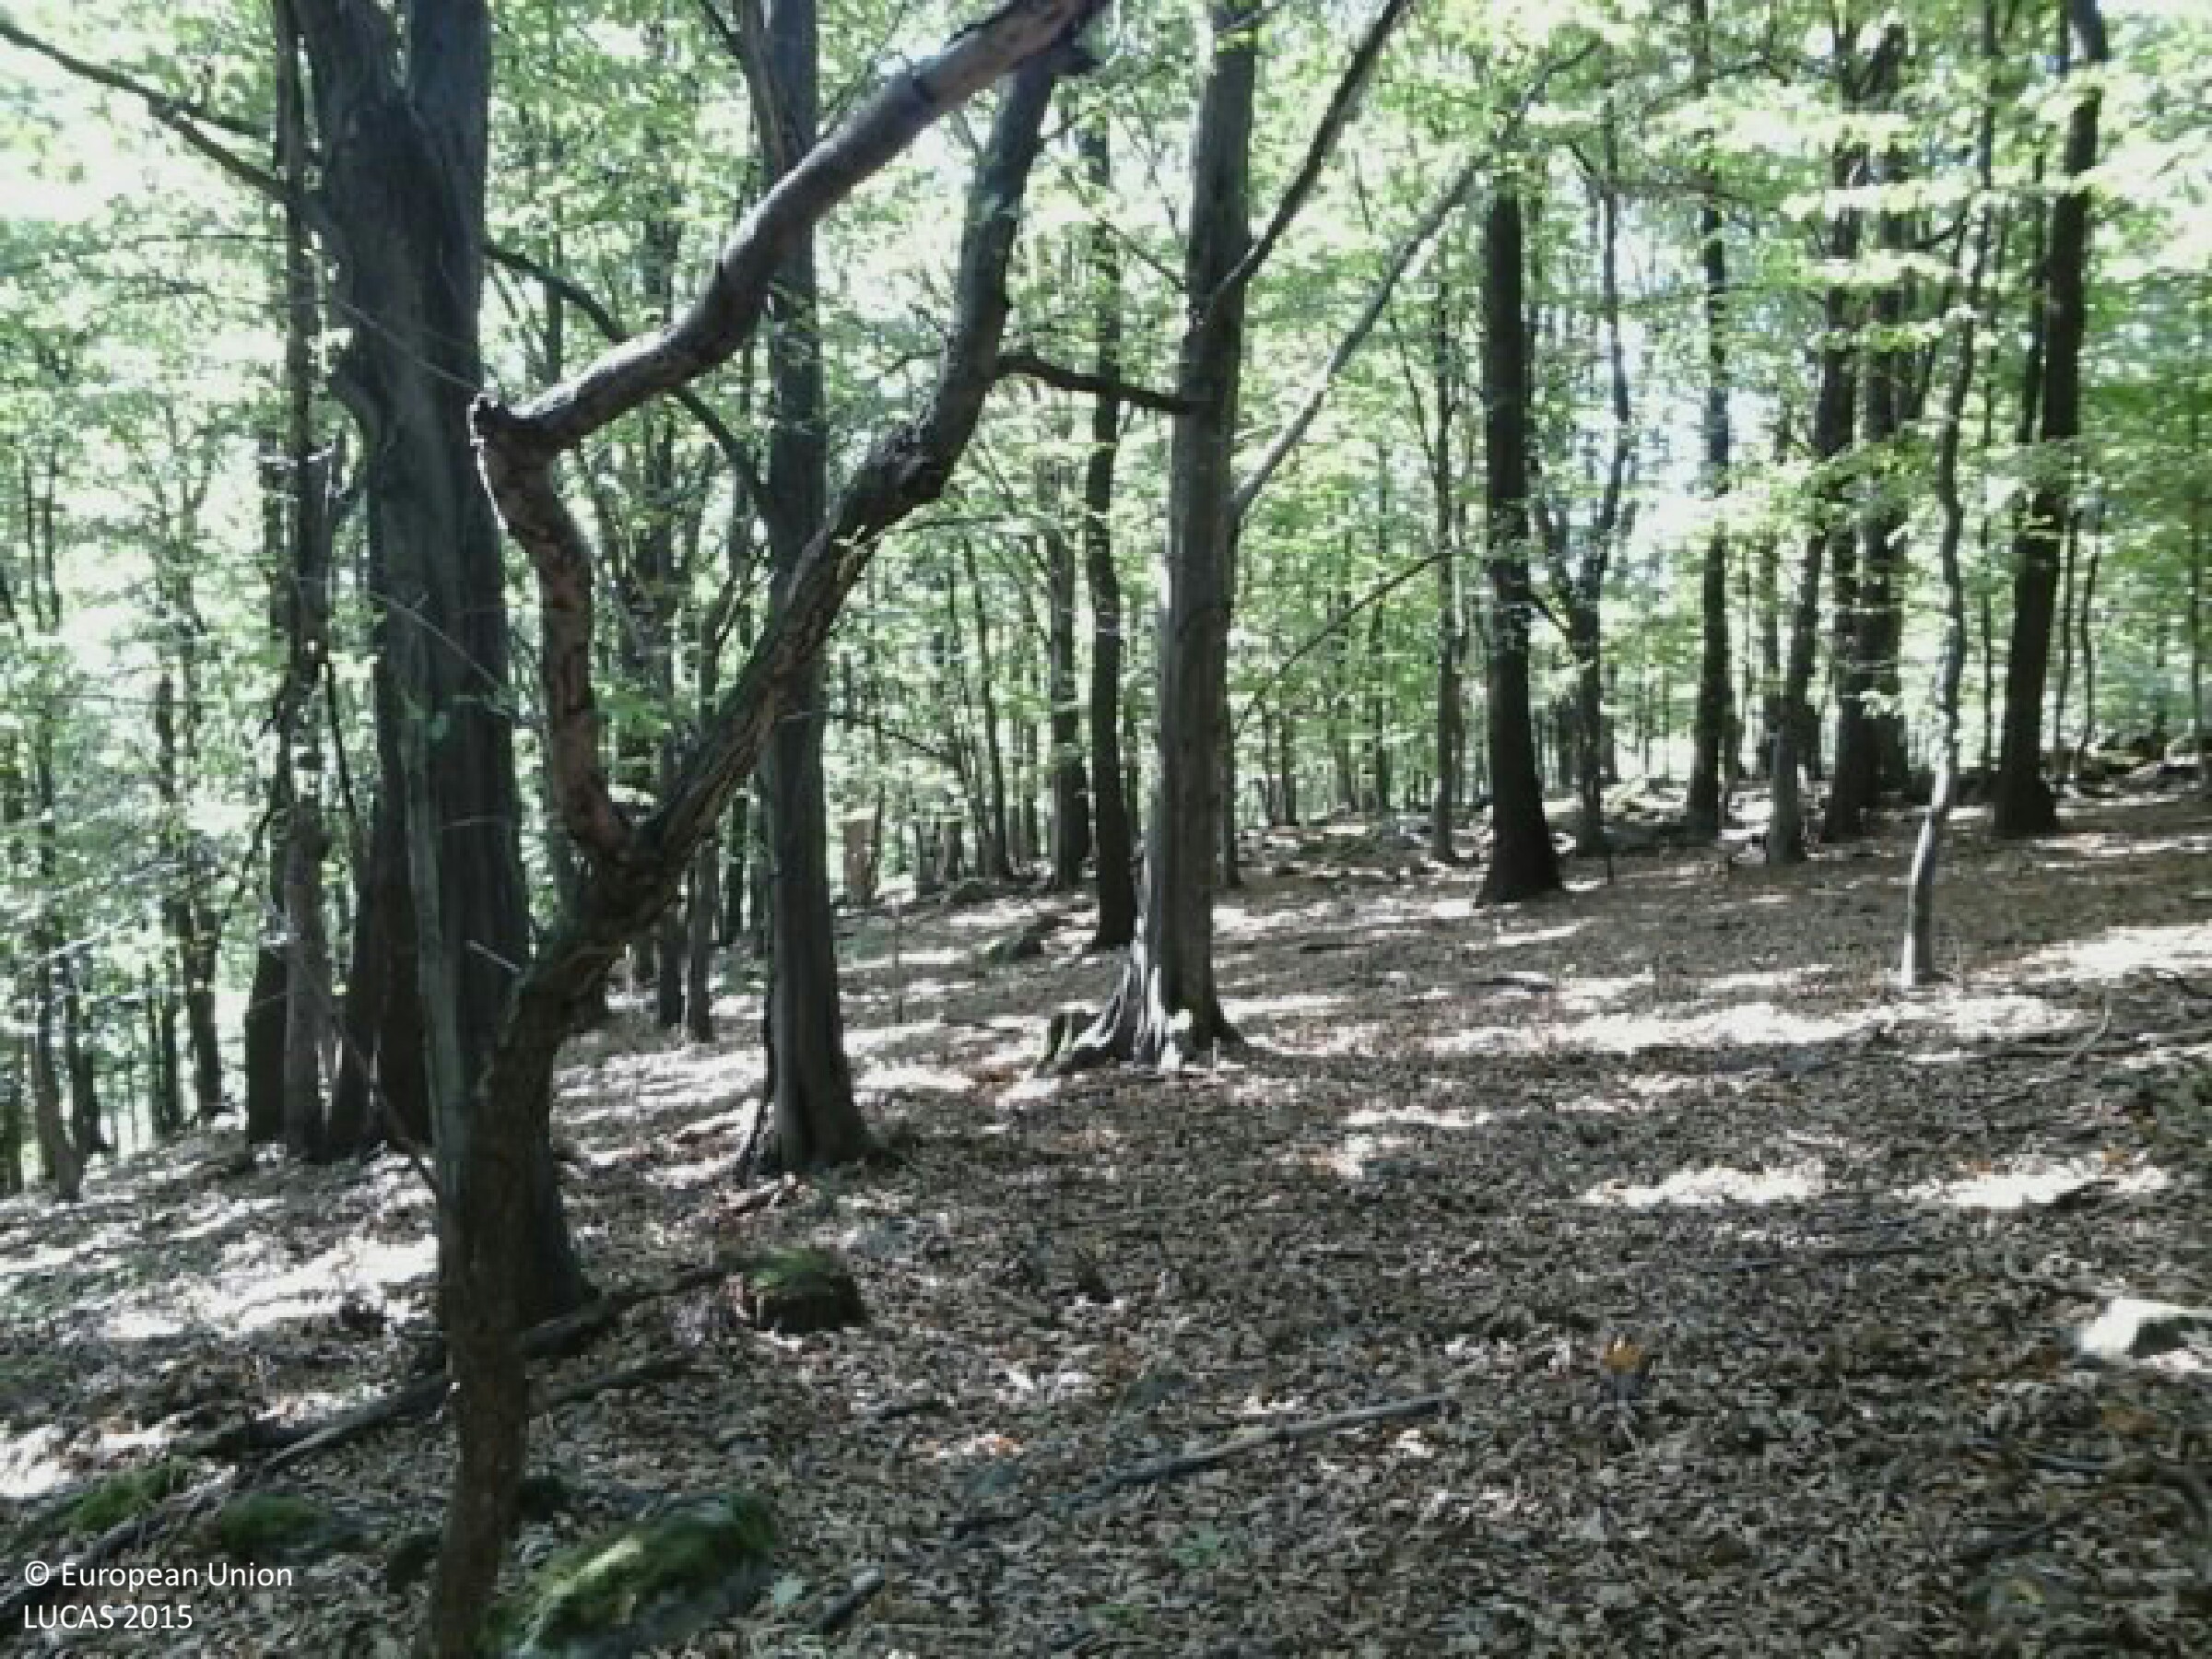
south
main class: Woodland
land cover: Broadleaved woodland
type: beech forest
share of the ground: > 75 %
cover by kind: broadleaved forest trees 100 %
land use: Forestry
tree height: > 5 m
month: September
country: HU
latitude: 47.8896
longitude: 19.8562
